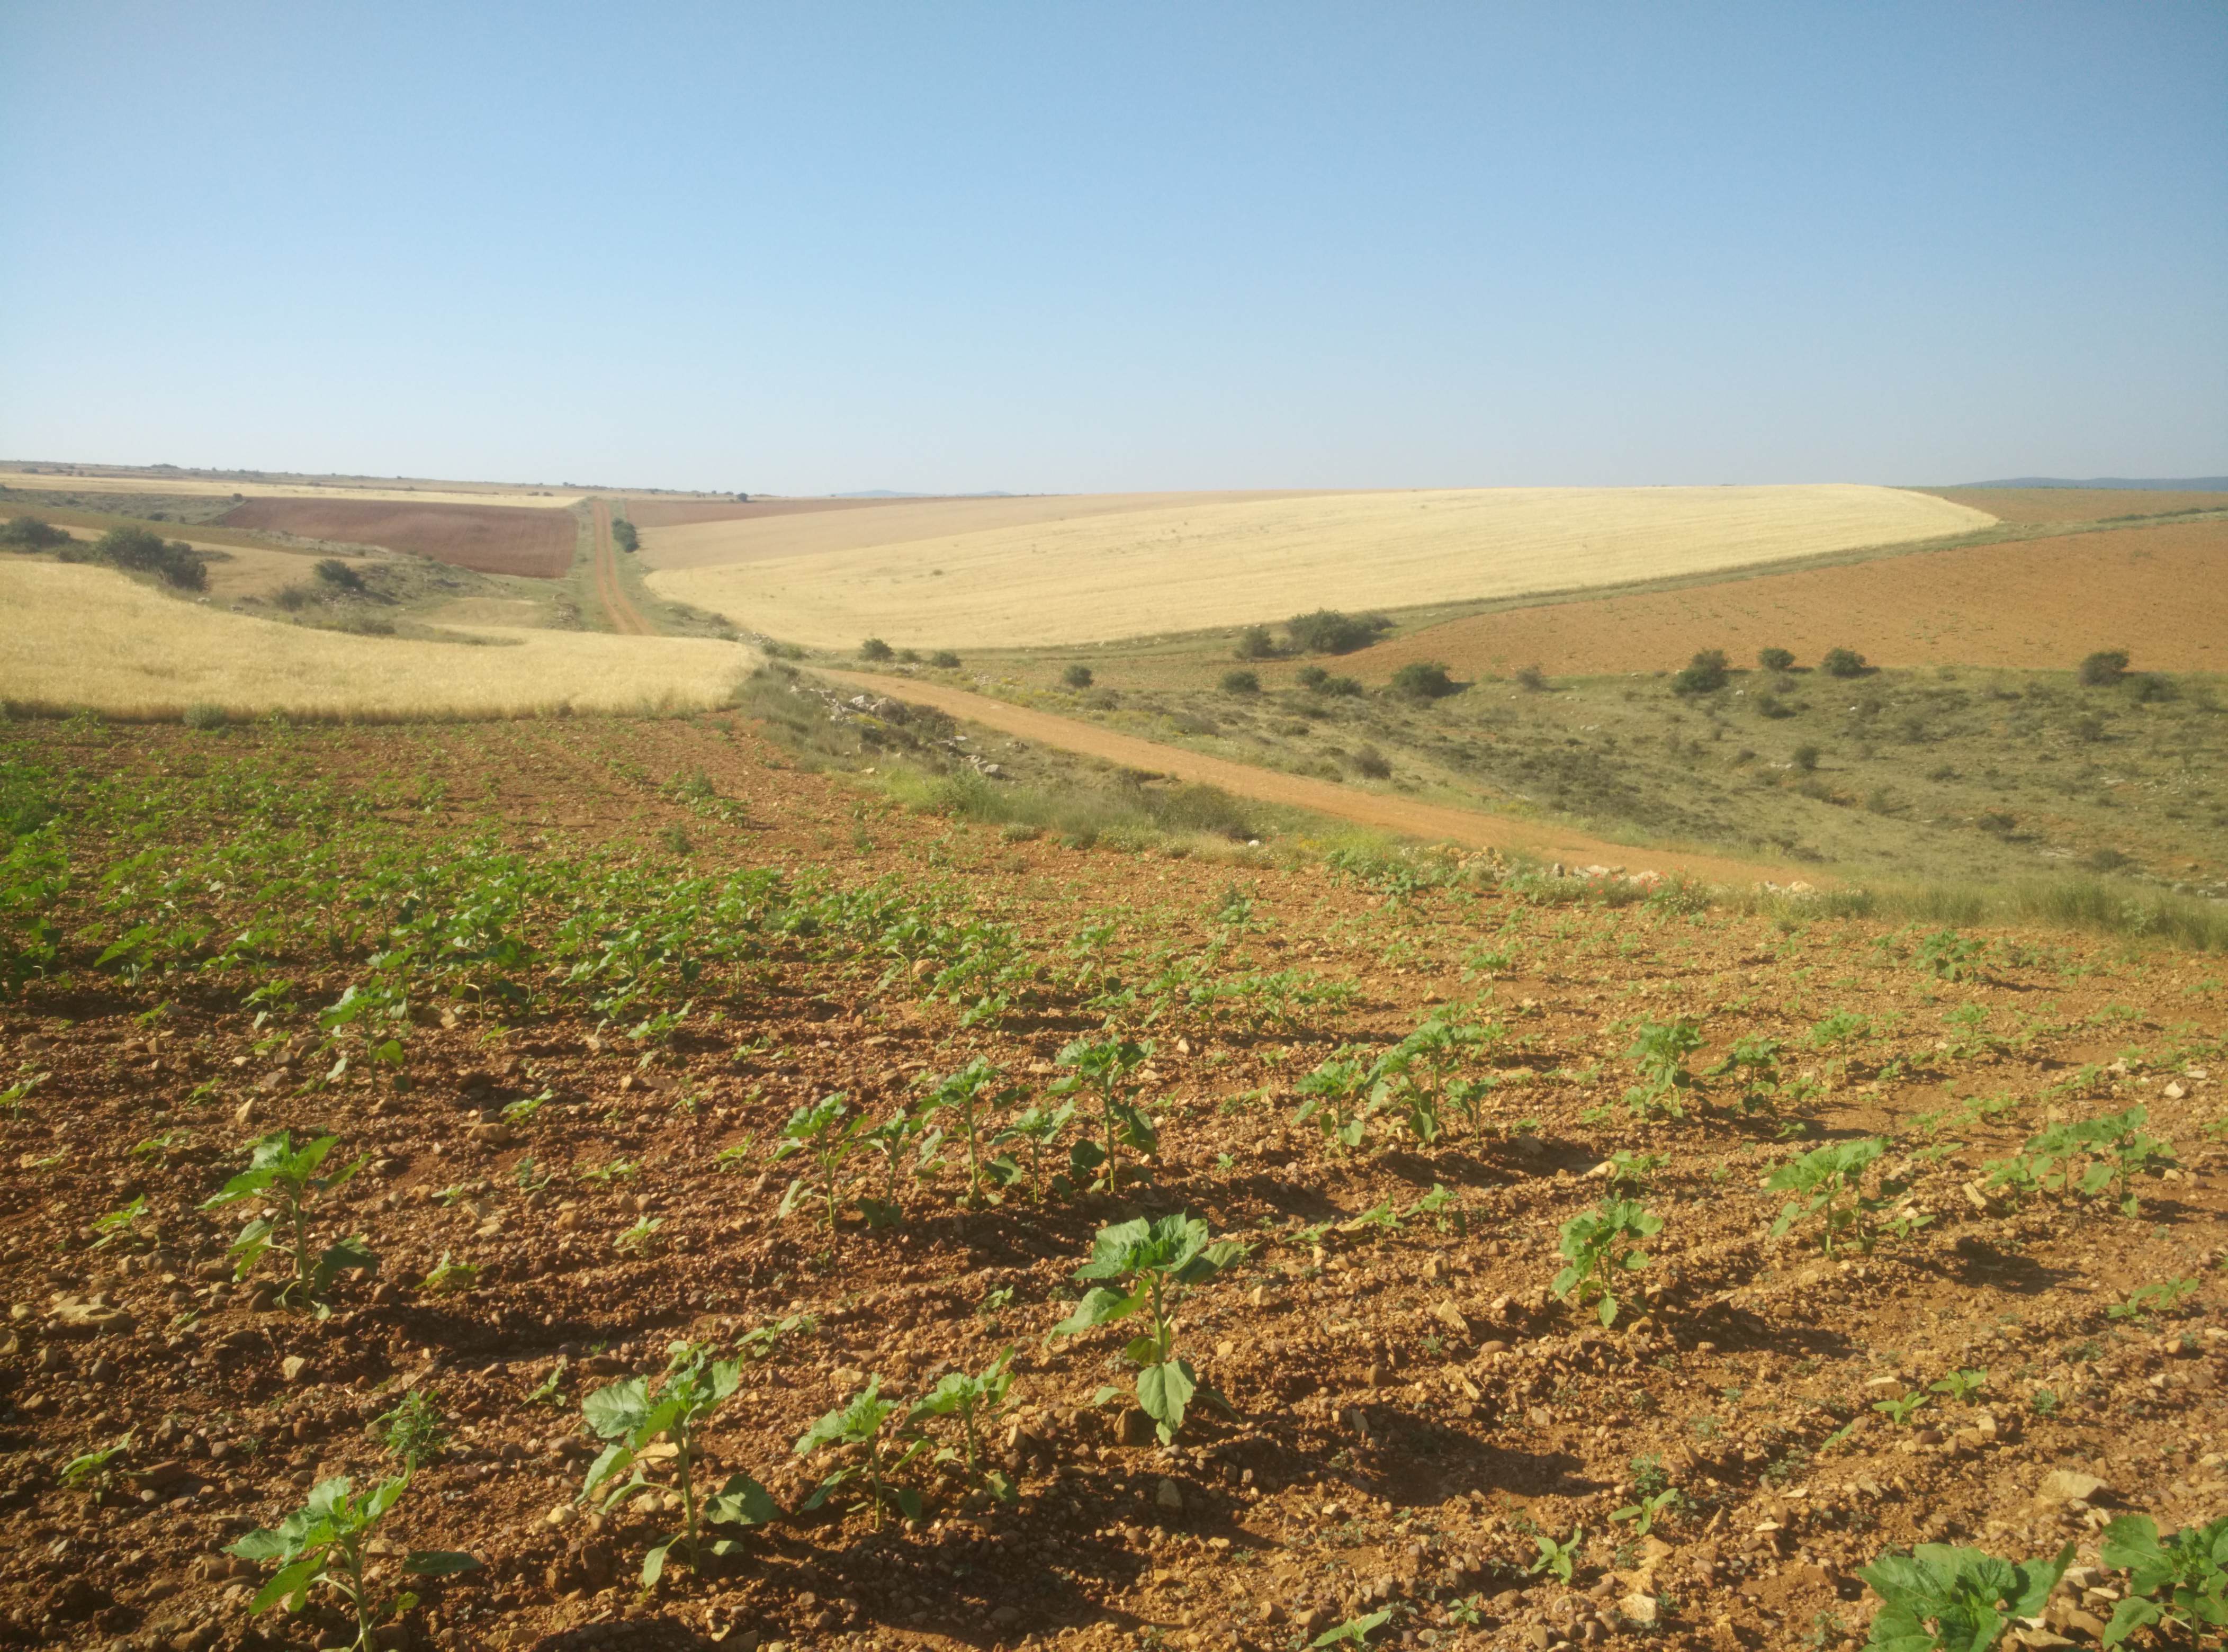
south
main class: Cropland
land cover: Sunflower
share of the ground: 25 - 50 %
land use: Agriculture (excluding fallow land and kitchen gardens)
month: June
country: ES
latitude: 40.7804
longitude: -1.7630
